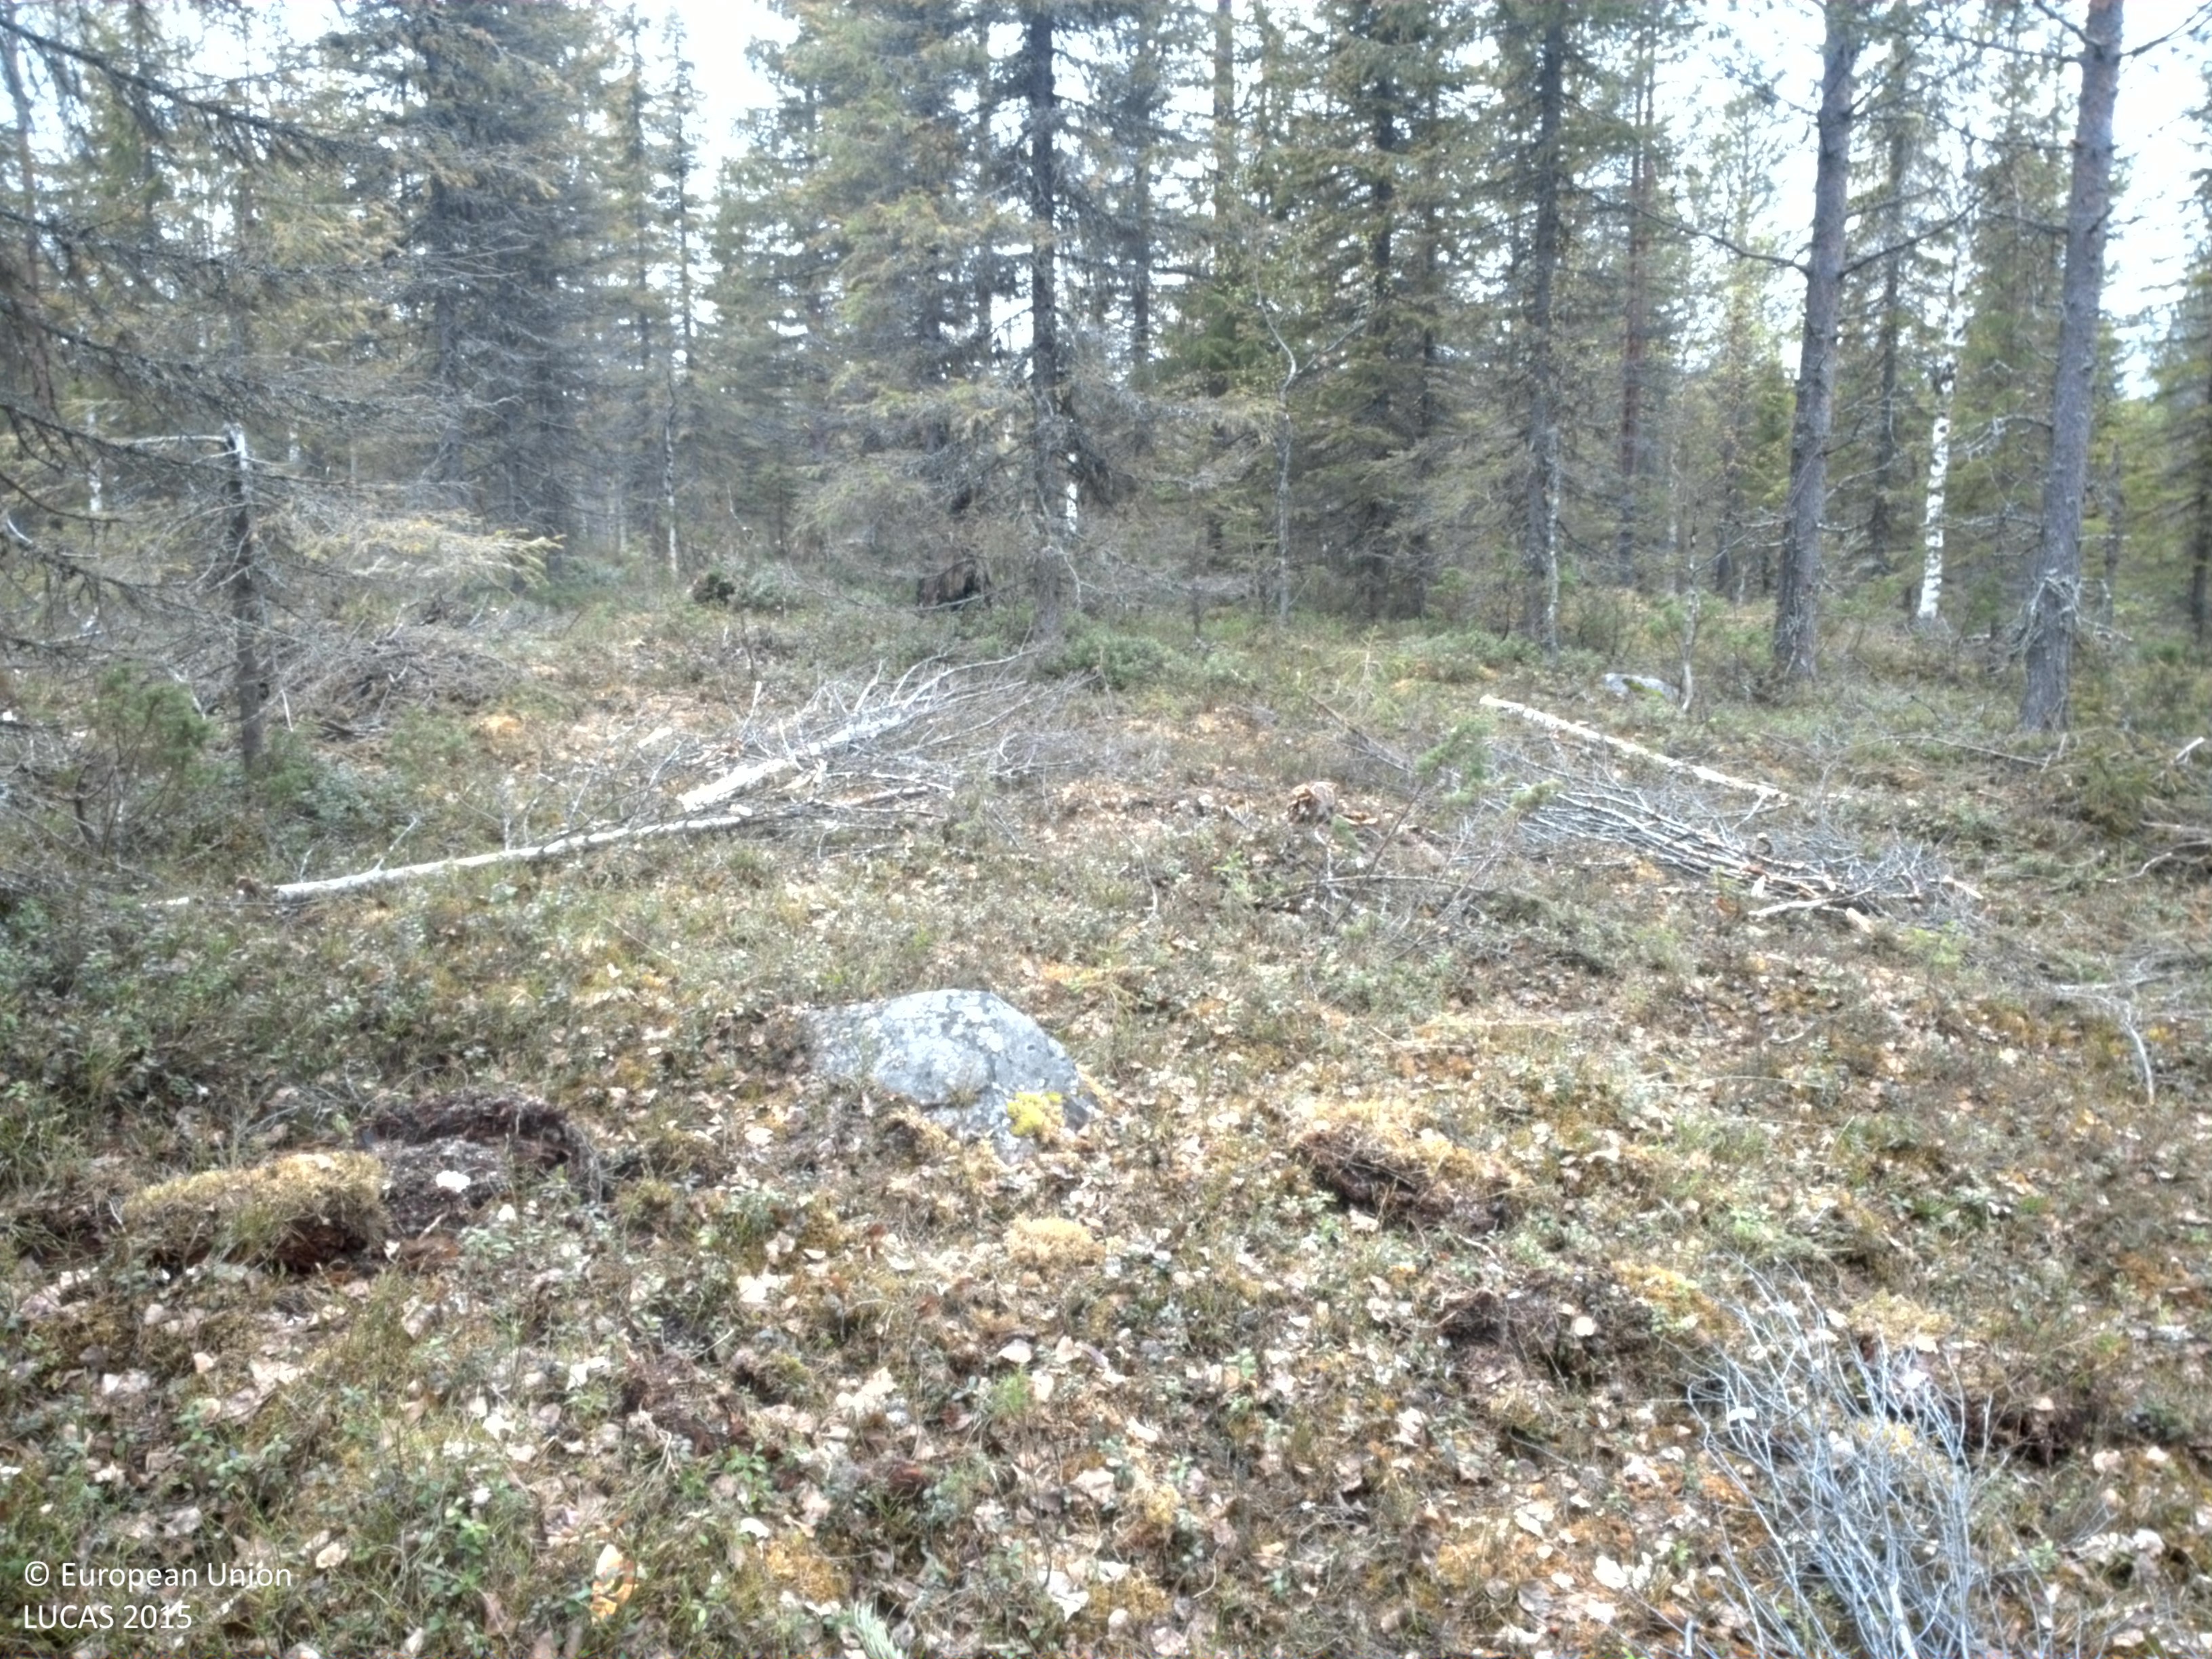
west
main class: Woodland
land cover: Spruce dominated mixed woodland
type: boreal forest
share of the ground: 50 - 75 %
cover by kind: coniferous forest trees 55 %, shrubs 25 %, broadleaved forest trees 20 %
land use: Forestry
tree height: > 5 m
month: June
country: SE
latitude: 66.4982
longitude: 23.3531
